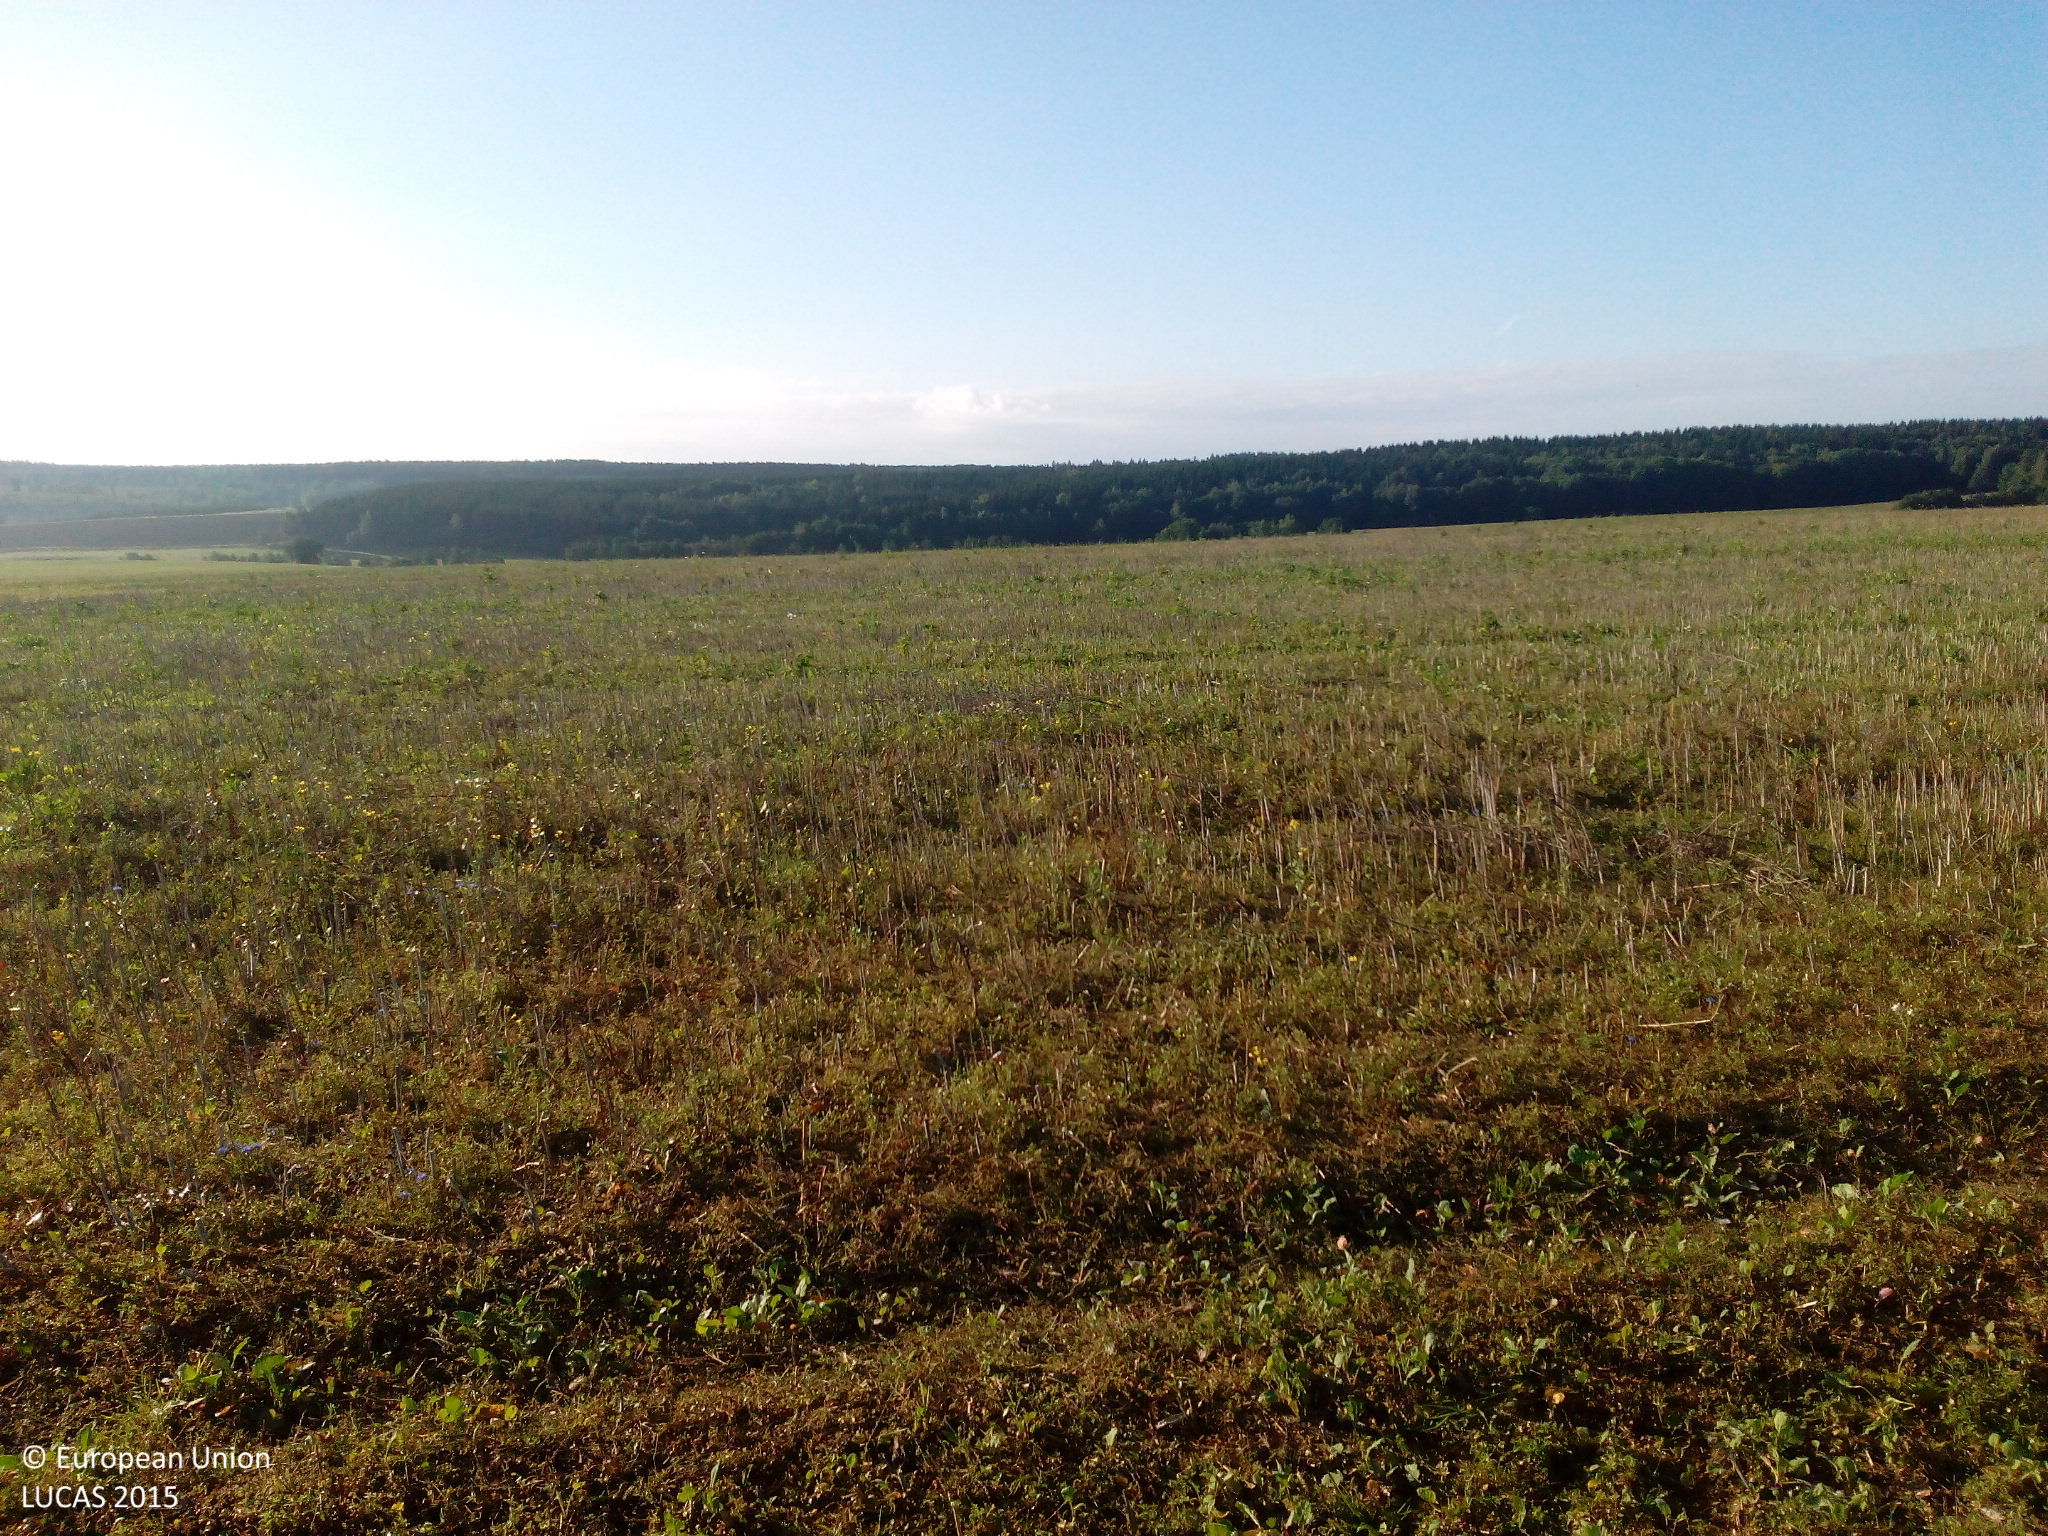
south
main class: Cropland
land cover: Rape and turnip rape
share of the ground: > 75 %
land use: Agriculture (excluding fallow land and kitchen gardens)
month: September
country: DE
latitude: 51.5456
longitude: 11.0812
